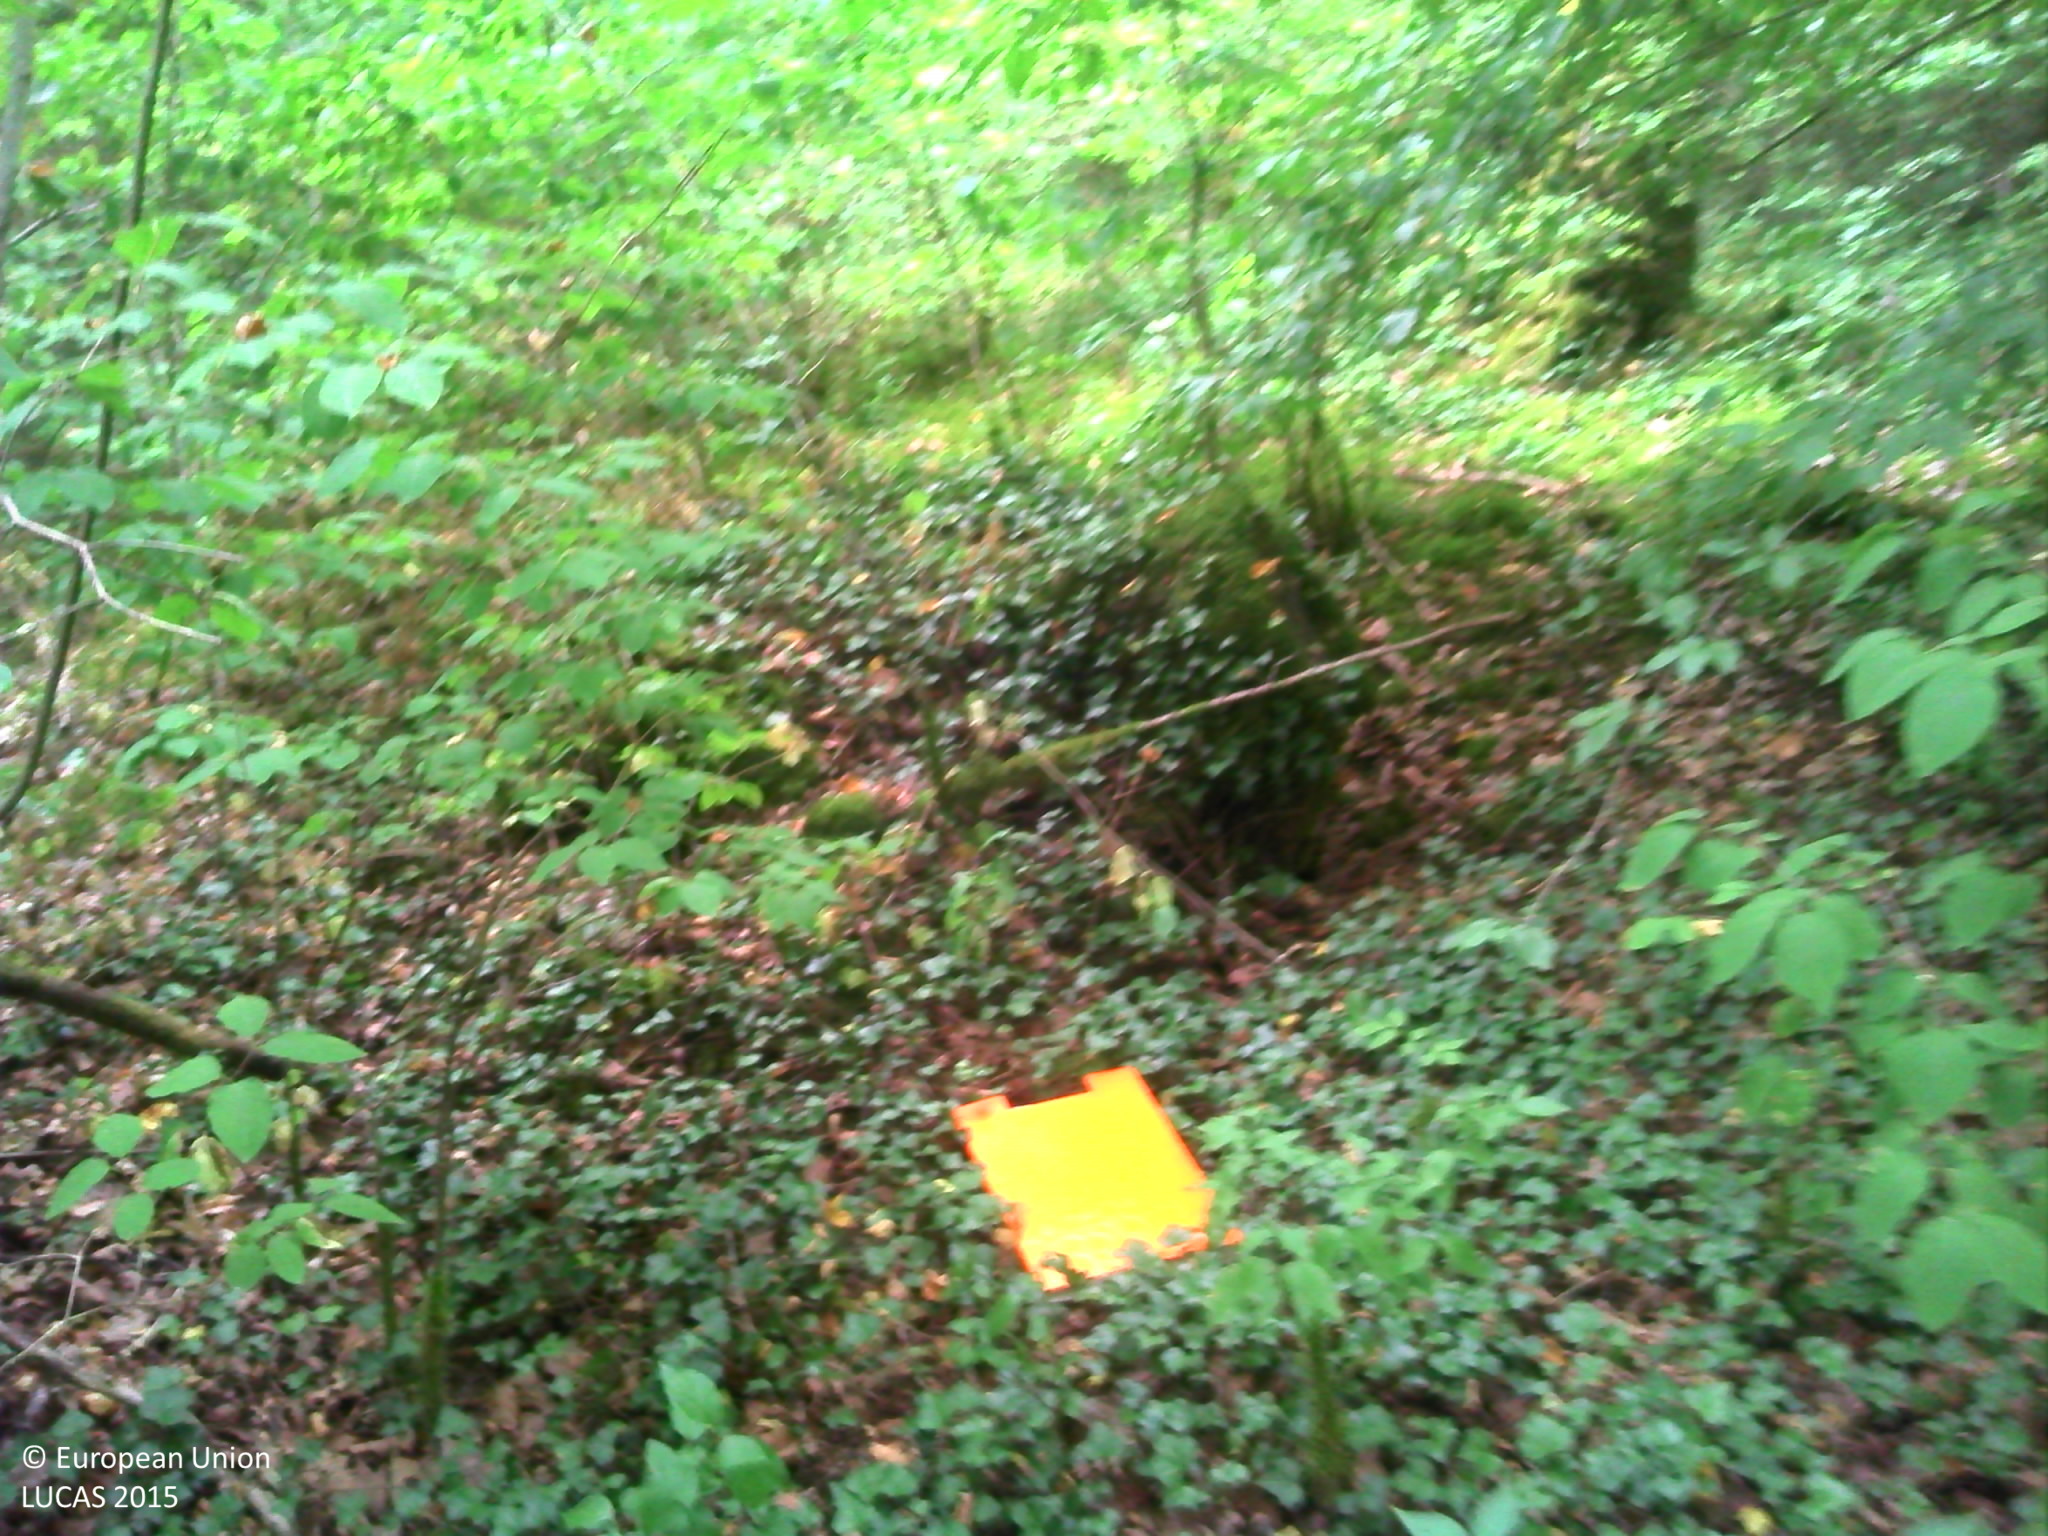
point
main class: Woodland
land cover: Broadleaved woodland
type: acidophilous oak and oak-birch forest
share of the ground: > 75 %
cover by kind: broadleaved forest trees 80 %, herbaceous plants 10 %, coniferous forest trees 5 %, lichens and mosses 5 %
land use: Forestry
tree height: > 5 m
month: July
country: FR
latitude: 48.0450
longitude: 5.1568
